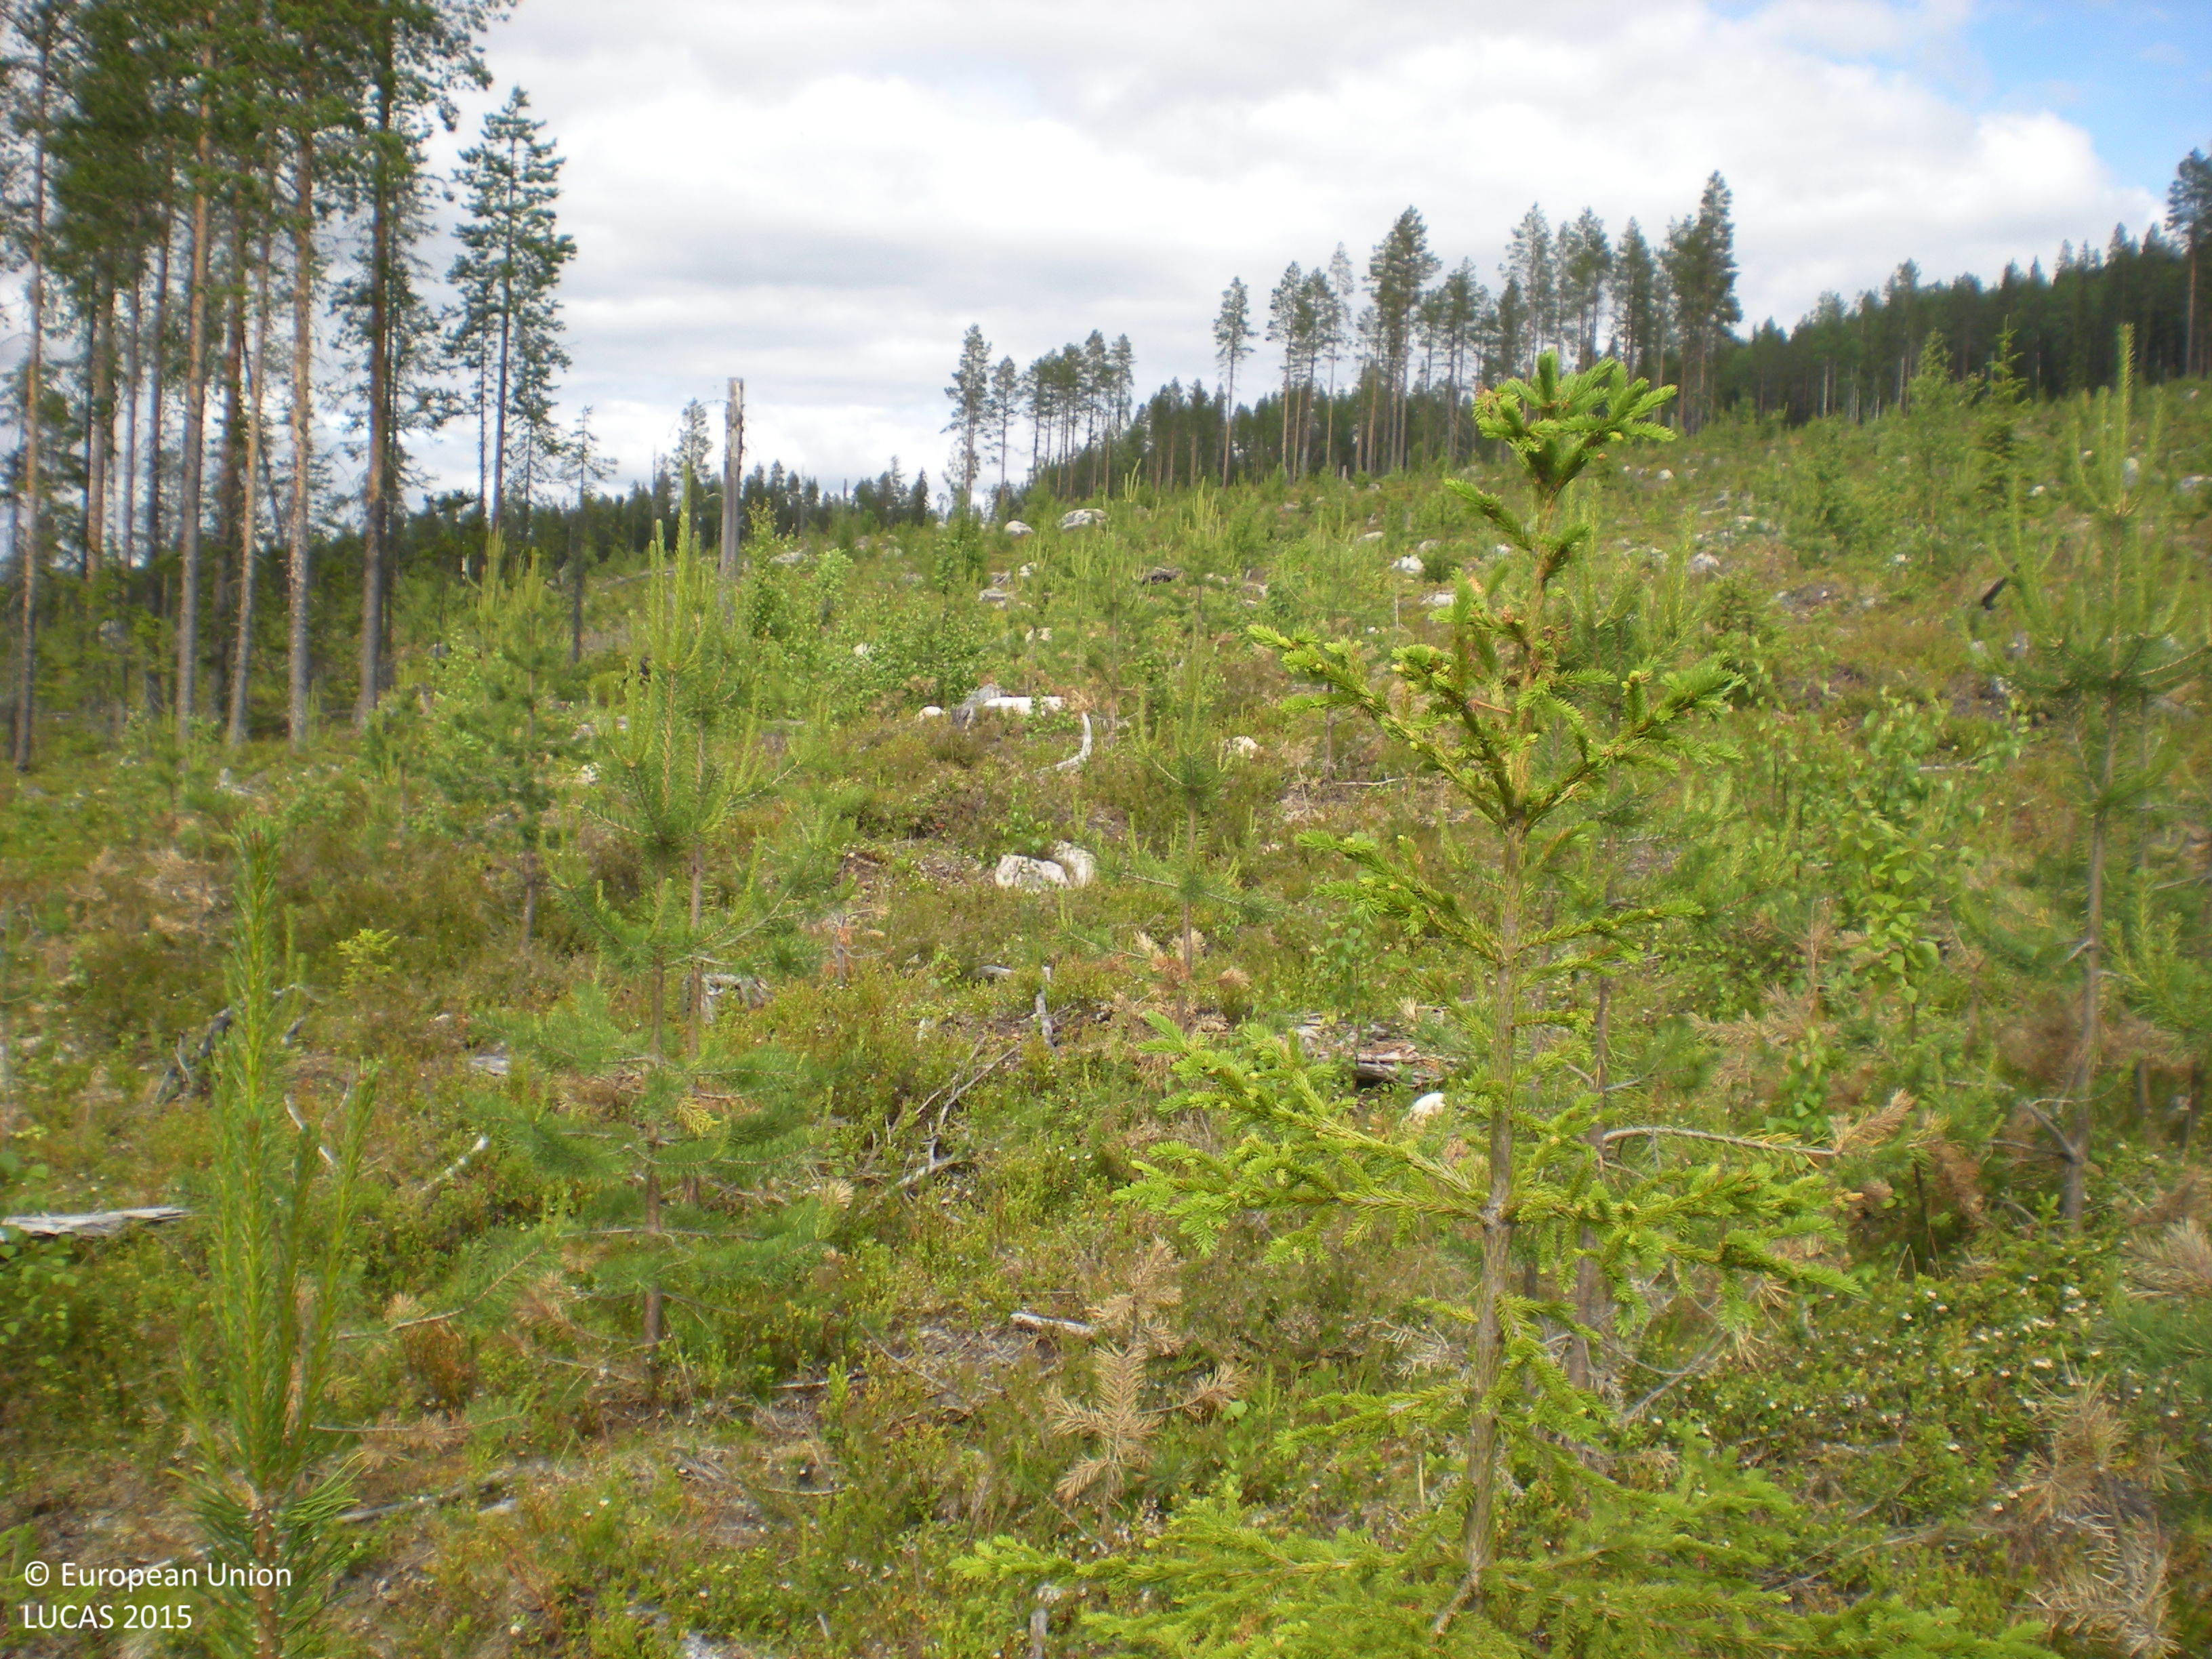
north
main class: Woodland
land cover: Pine dominated mixed woodland
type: boreal forest
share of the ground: 10 - 25 %
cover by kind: shrubs 60 %, coniferous forest trees 15 %, lichens and mosses 15 %, broadleaved forest trees 10 %
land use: Forestry
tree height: < 5 m
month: July
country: SE
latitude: 65.3983
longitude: 17.9472
